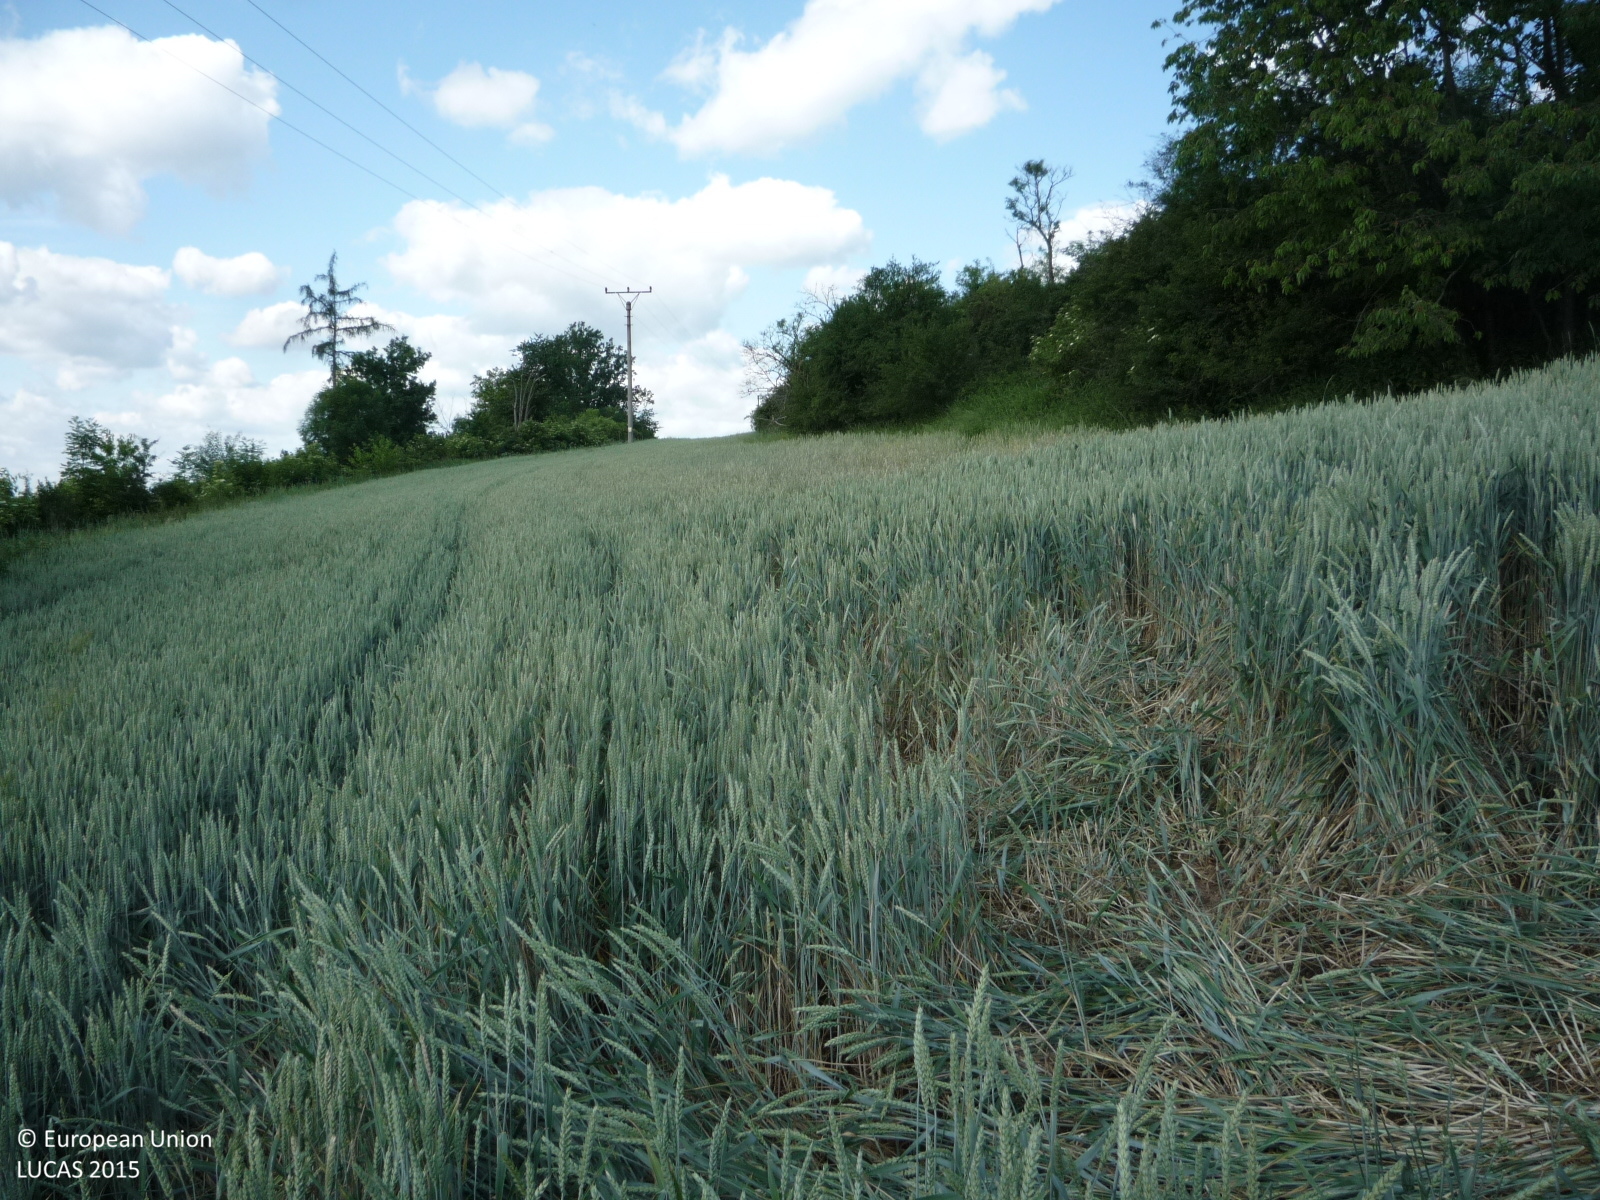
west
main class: Cropland
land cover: Common wheat
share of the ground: > 75 %
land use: Agriculture (excluding fallow land and kitchen gardens)
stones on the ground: < 10 %
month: June
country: CZ
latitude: 49.7448
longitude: 15.1237
